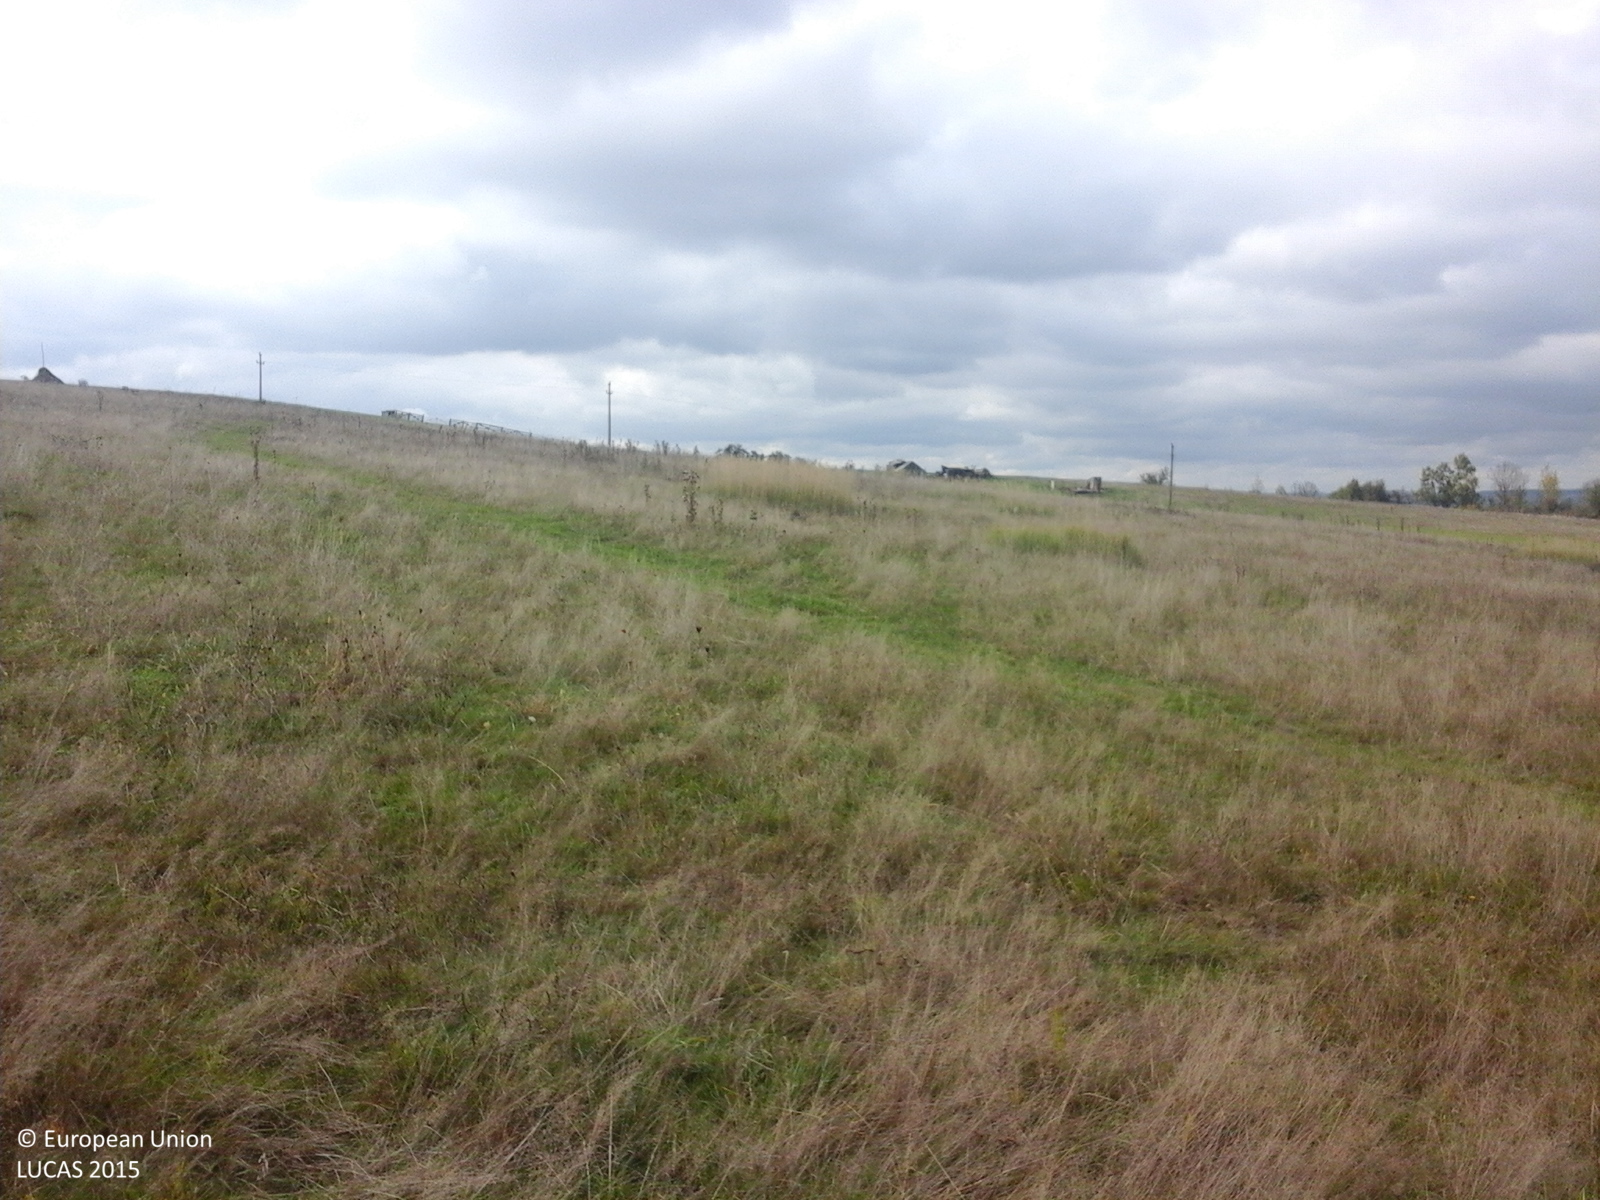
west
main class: Grassland
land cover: Grassland without tree/shrub cover
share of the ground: > 75 %
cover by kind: herbaceous plants 100 %
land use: Agriculture (excluding fallow land and kitchen gardens)
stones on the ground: < 10 %
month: October
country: RO
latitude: 45.9397
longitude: 24.6481
